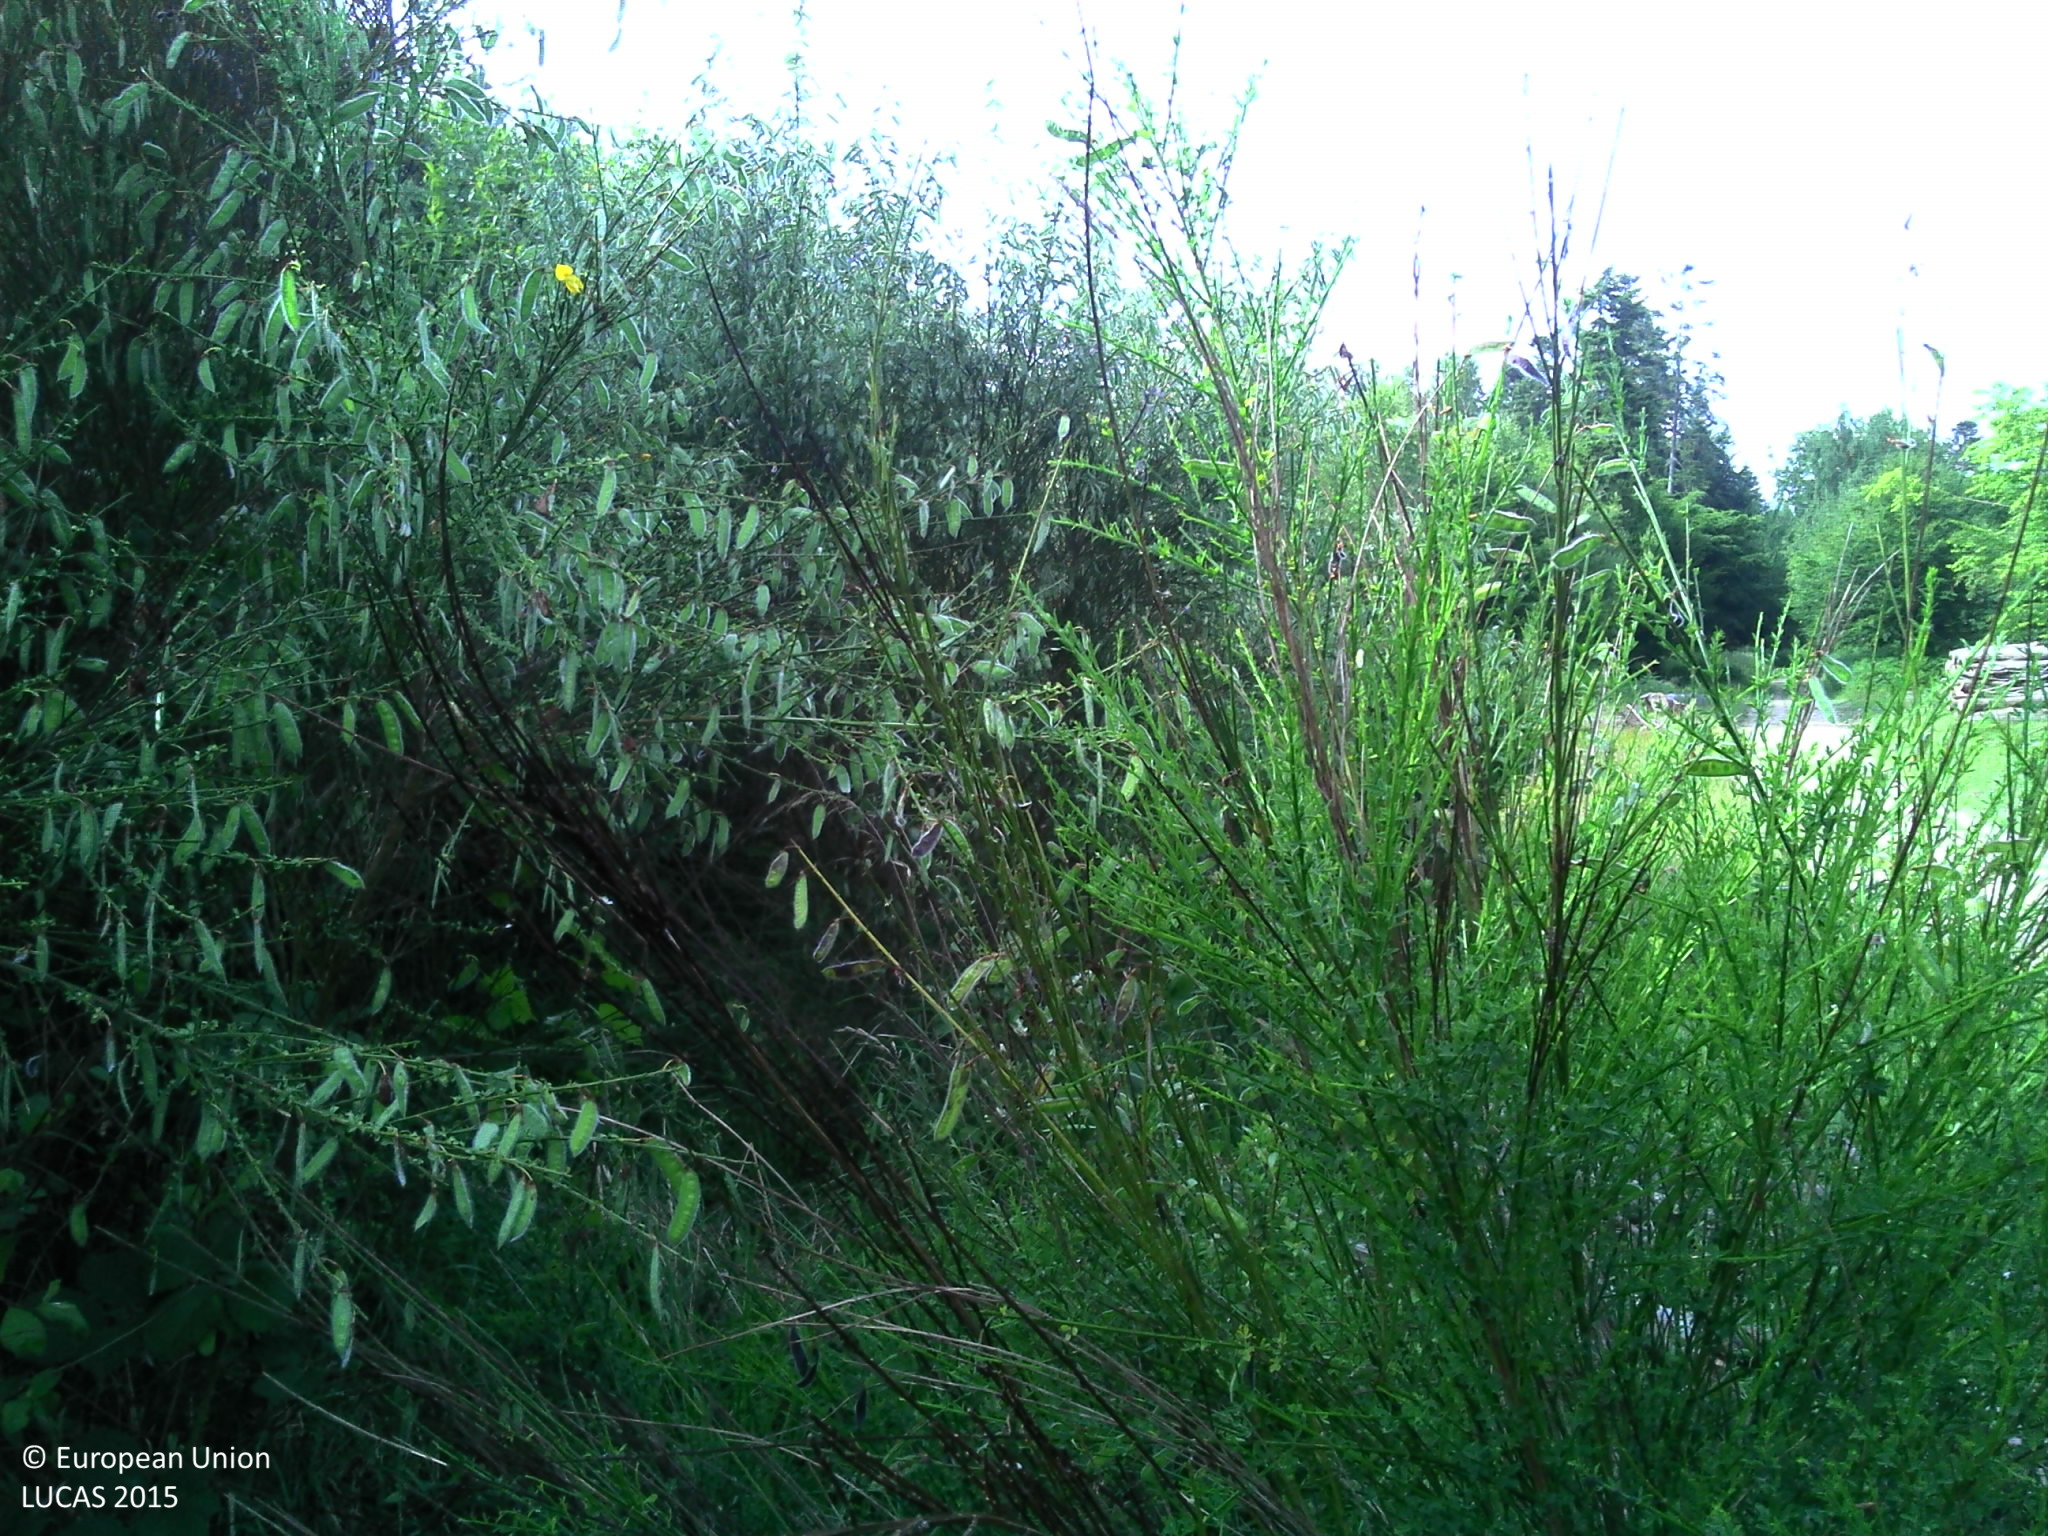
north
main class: Grassland
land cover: Spontaneously vegetated surfaces
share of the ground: > 75 %
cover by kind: herbaceous plants 100 %
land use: Semi-natural and natural areas not in use
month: June
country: FR
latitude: 49.2779
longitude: 1.1406
